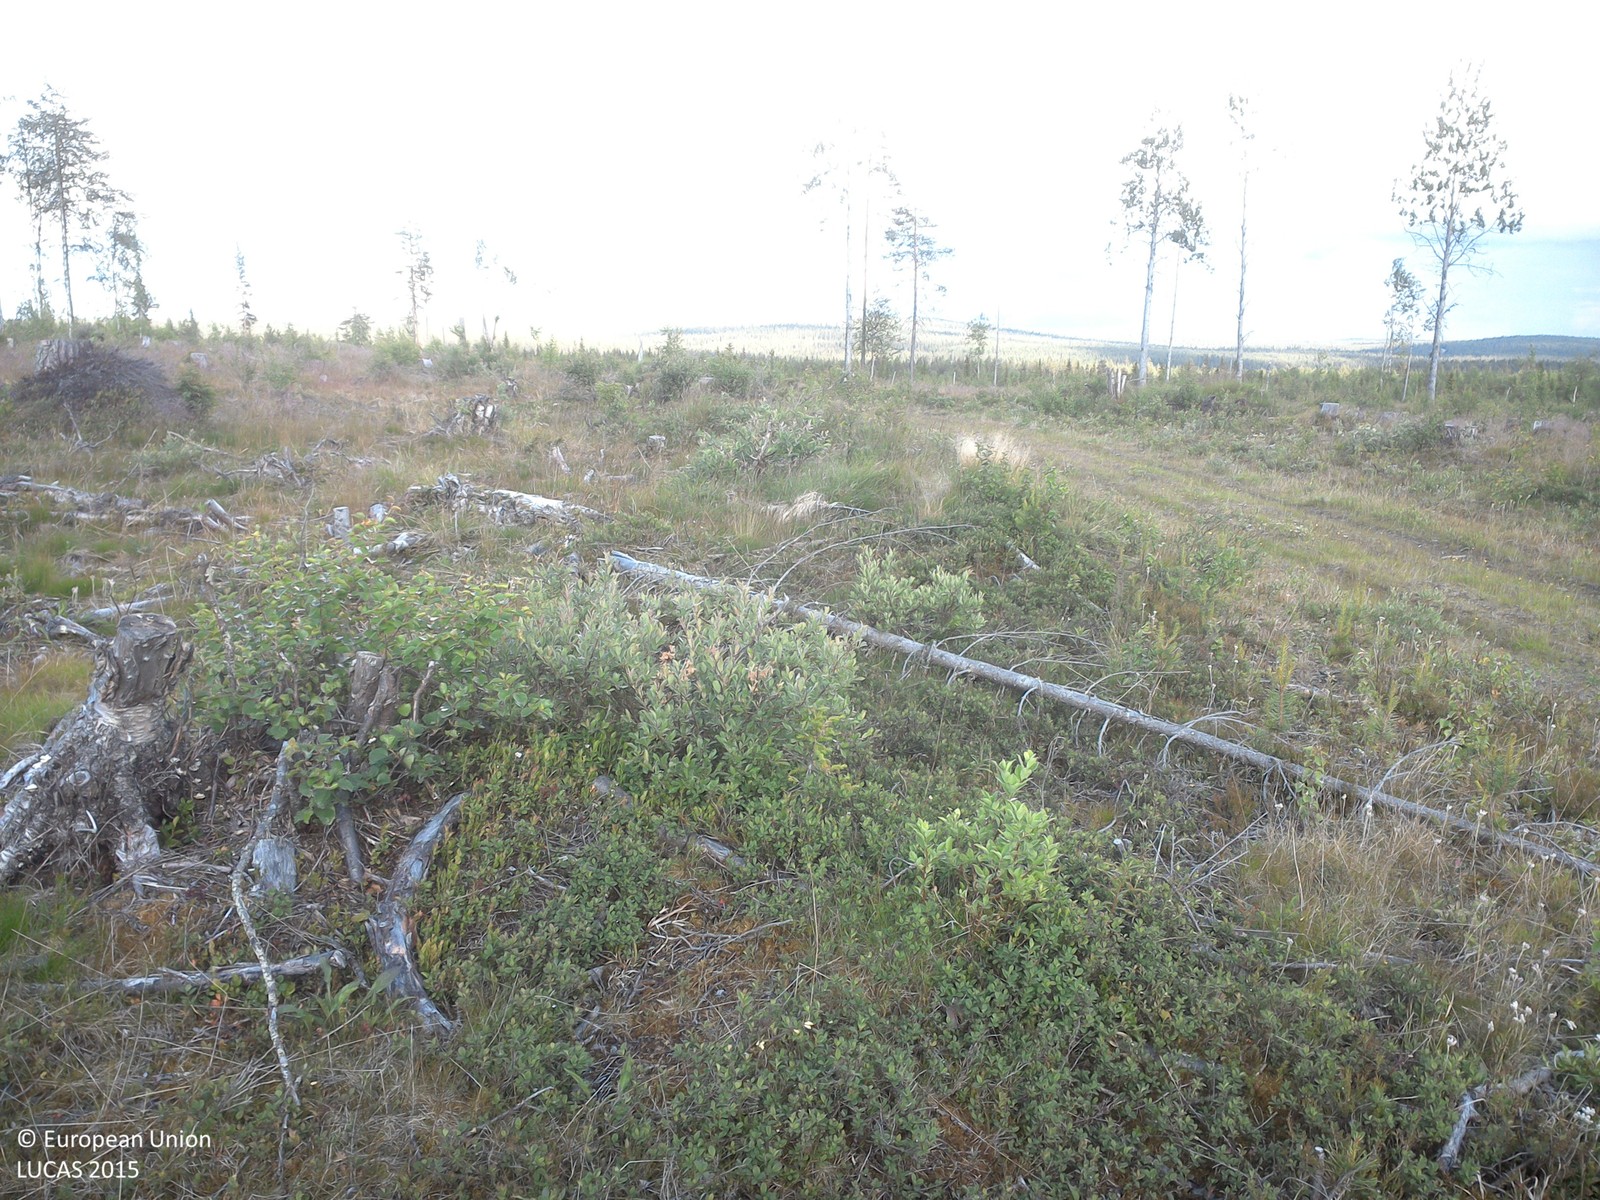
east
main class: Shrubland
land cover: Shrubland with sparse tree cover
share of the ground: 25 - 50 %
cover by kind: herbaceous plants 40 %, shrubs 25 %, unconsolidated bare surface 20 %, lichens and mosses 10 %, broadleaved forest trees 5 %
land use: Forestry
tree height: < 5 m
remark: Clear cut
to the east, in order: Shrubland with sparse tree cover; Tracks; Shrubland with sparse tree cover
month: July
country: SE
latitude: 67.7076
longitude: 23.4541
